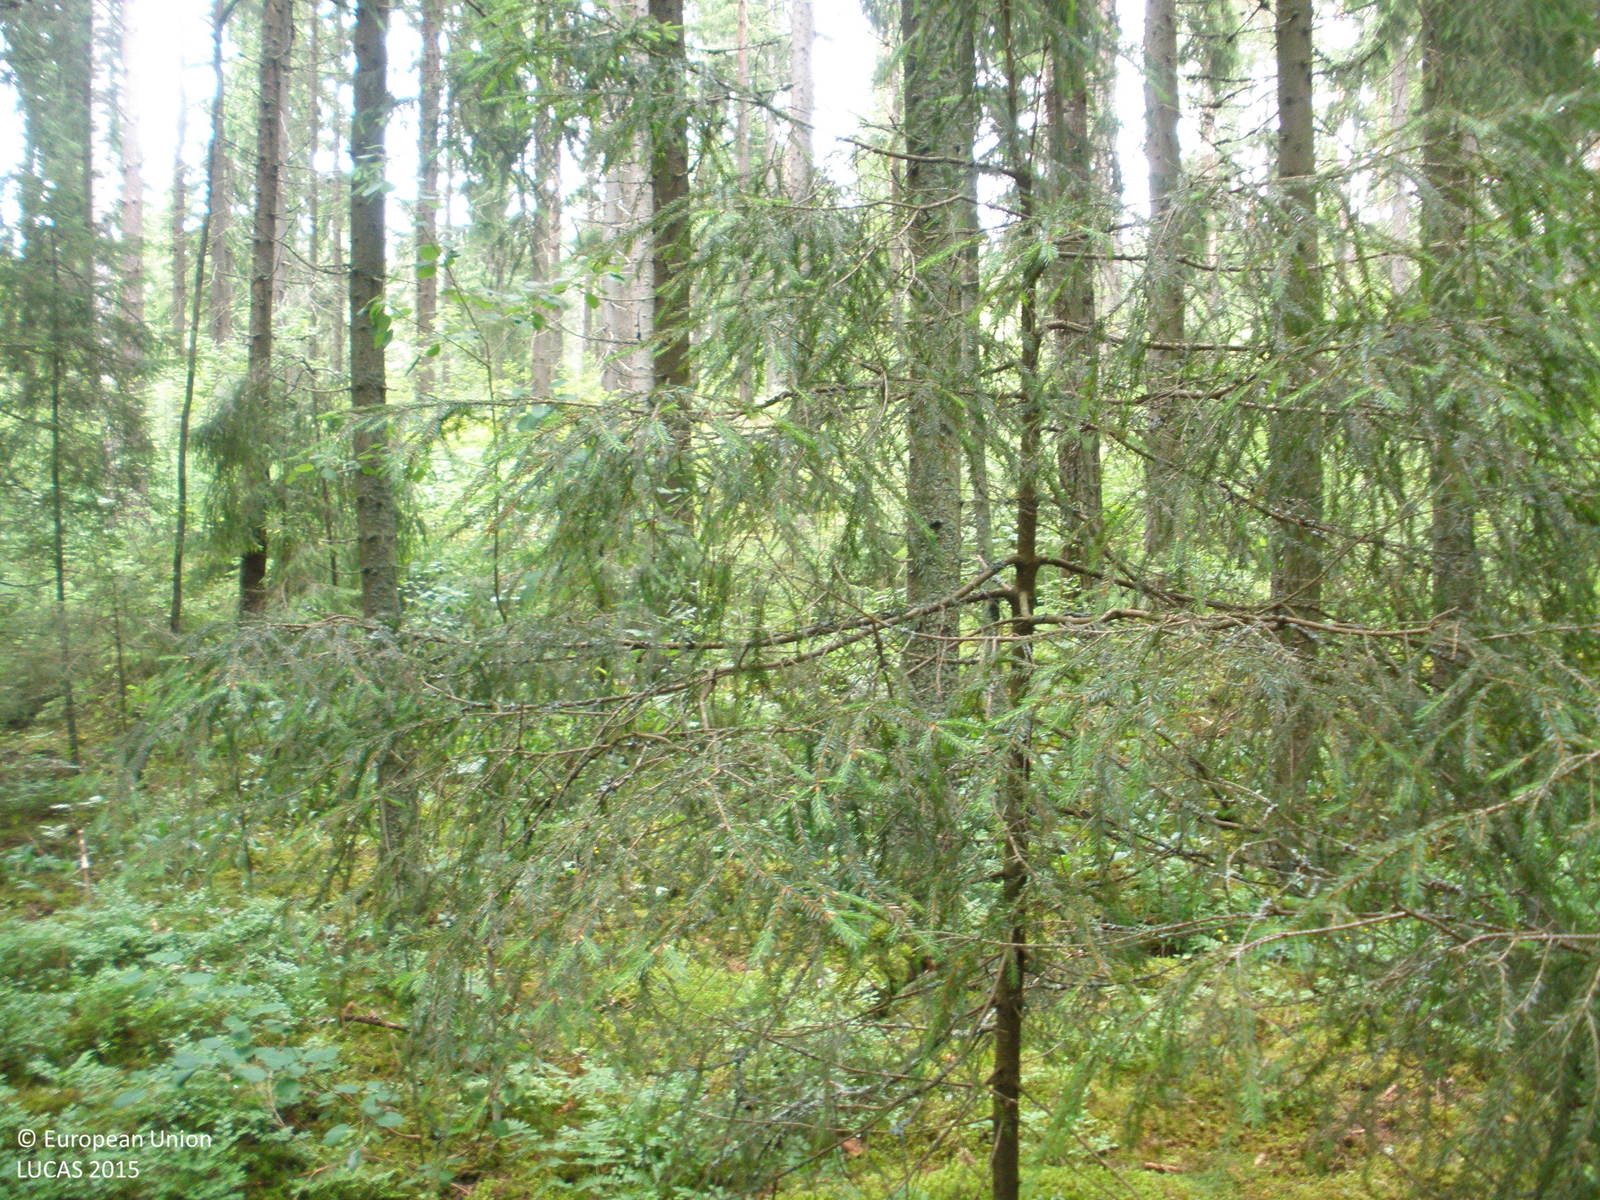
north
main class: Woodland
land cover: Spruce dominated coniferous woodland
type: boreal forest
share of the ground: > 75 %
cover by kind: coniferous forest trees 80 %, herbaceous plants 10 %, broadleaved forest trees 5 %, lichens and mosses 5 %
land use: Forestry
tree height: > 5 m
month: July
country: FI
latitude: 61.3392
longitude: 23.7097
